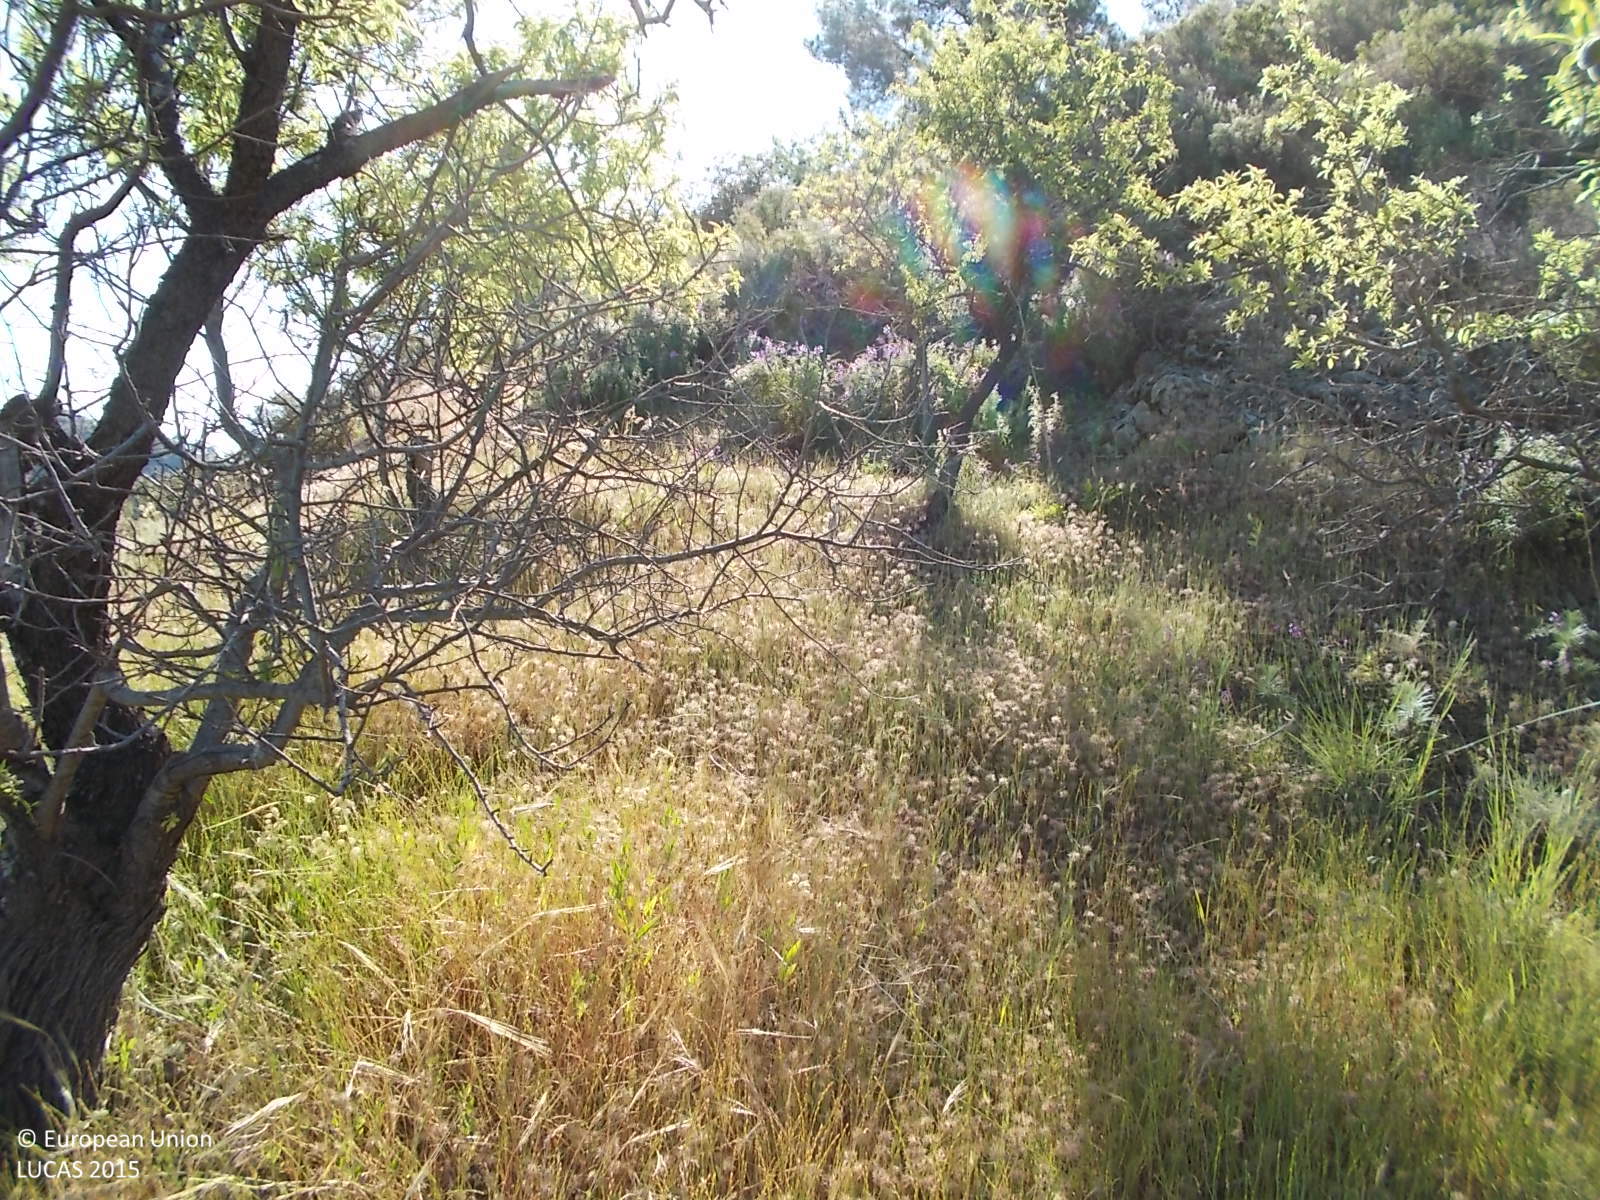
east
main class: Woodland
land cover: Pine dominated coniferous woodland
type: coniferous forest of the mediterranean region
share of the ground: > 75 %
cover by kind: coniferous forest trees 100 %
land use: Semi-natural and natural areas not in use
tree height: > 5 m
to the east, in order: Pine dominated coniferous woodland; Dry stone walls; Pine dominated coniferous woodland; Dry stone walls; Nuts trees; Grassland with sparse tree/shrub cover; Dry stone walls; Nuts trees; Shrubland with sparse tree cover; Pine dominated coniferous woodland
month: May
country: CY
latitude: 34.9676
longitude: 33.0545
